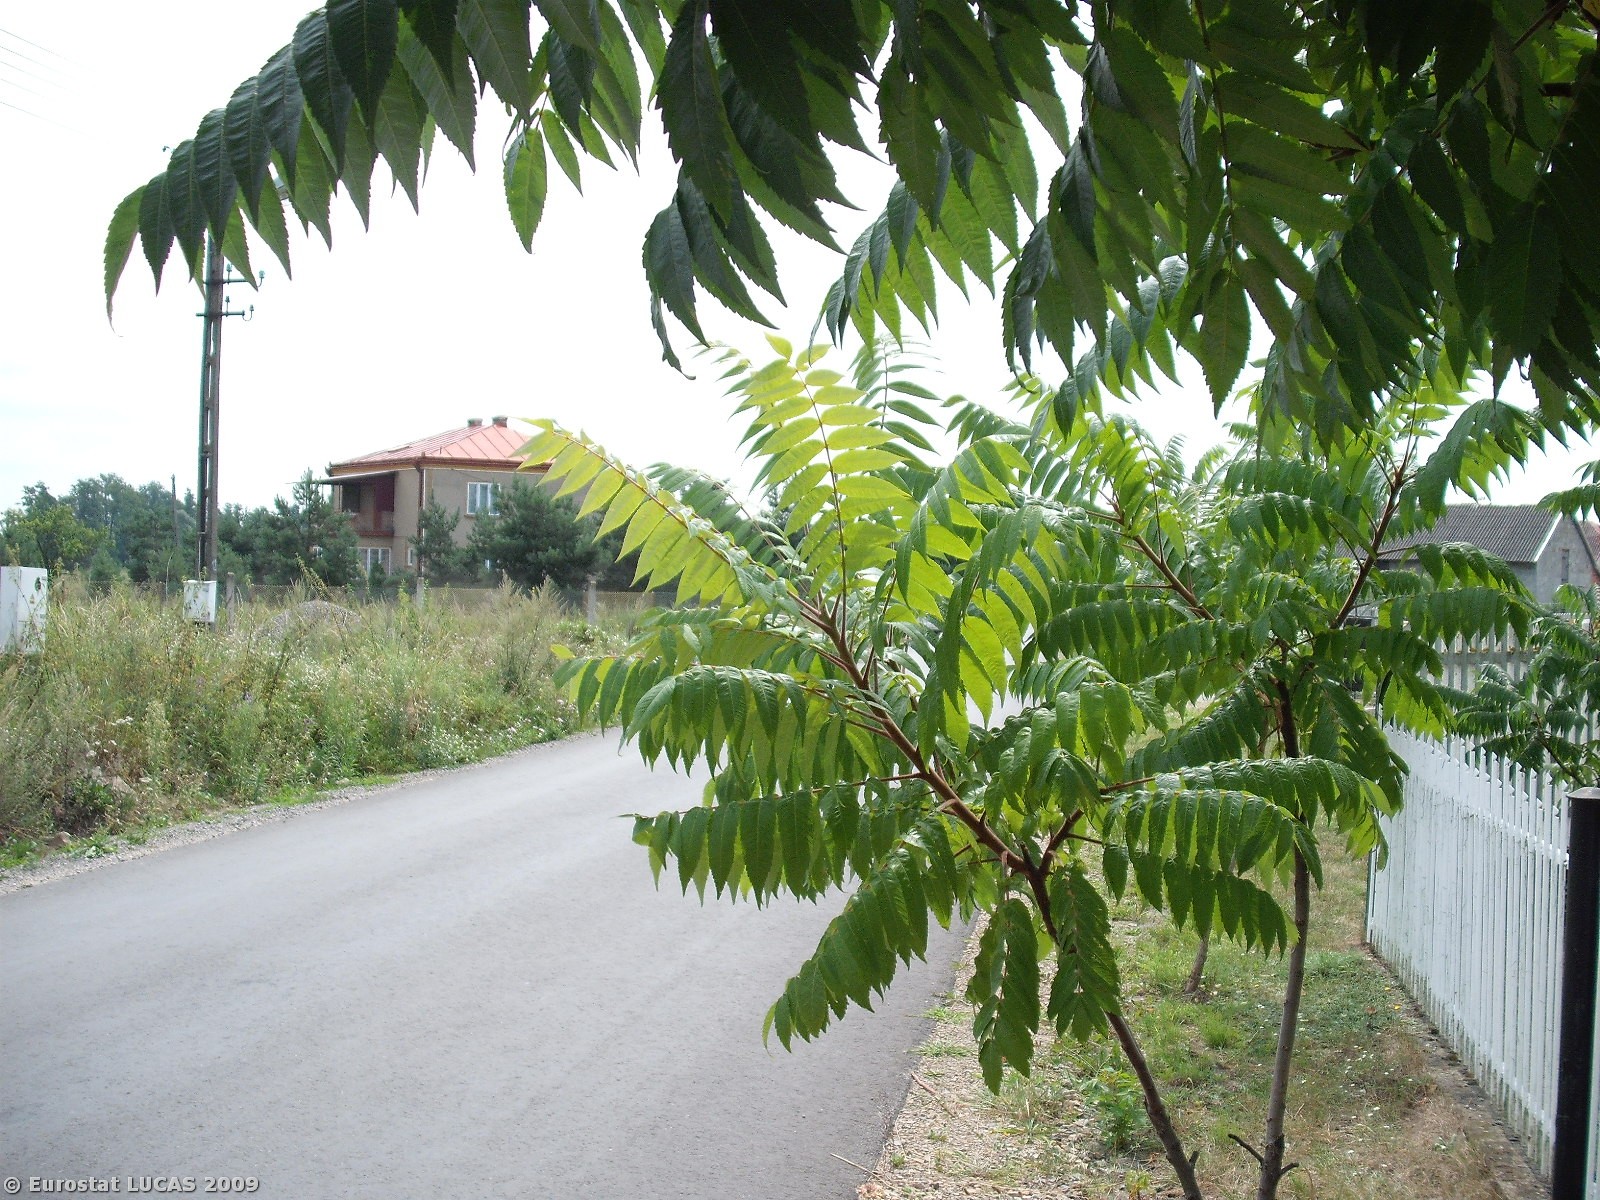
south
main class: Grassland
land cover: Grassland without tree/shrub cover
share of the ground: > 75 %
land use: Residential
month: August
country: PL
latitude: 50.5199
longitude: 21.2032
